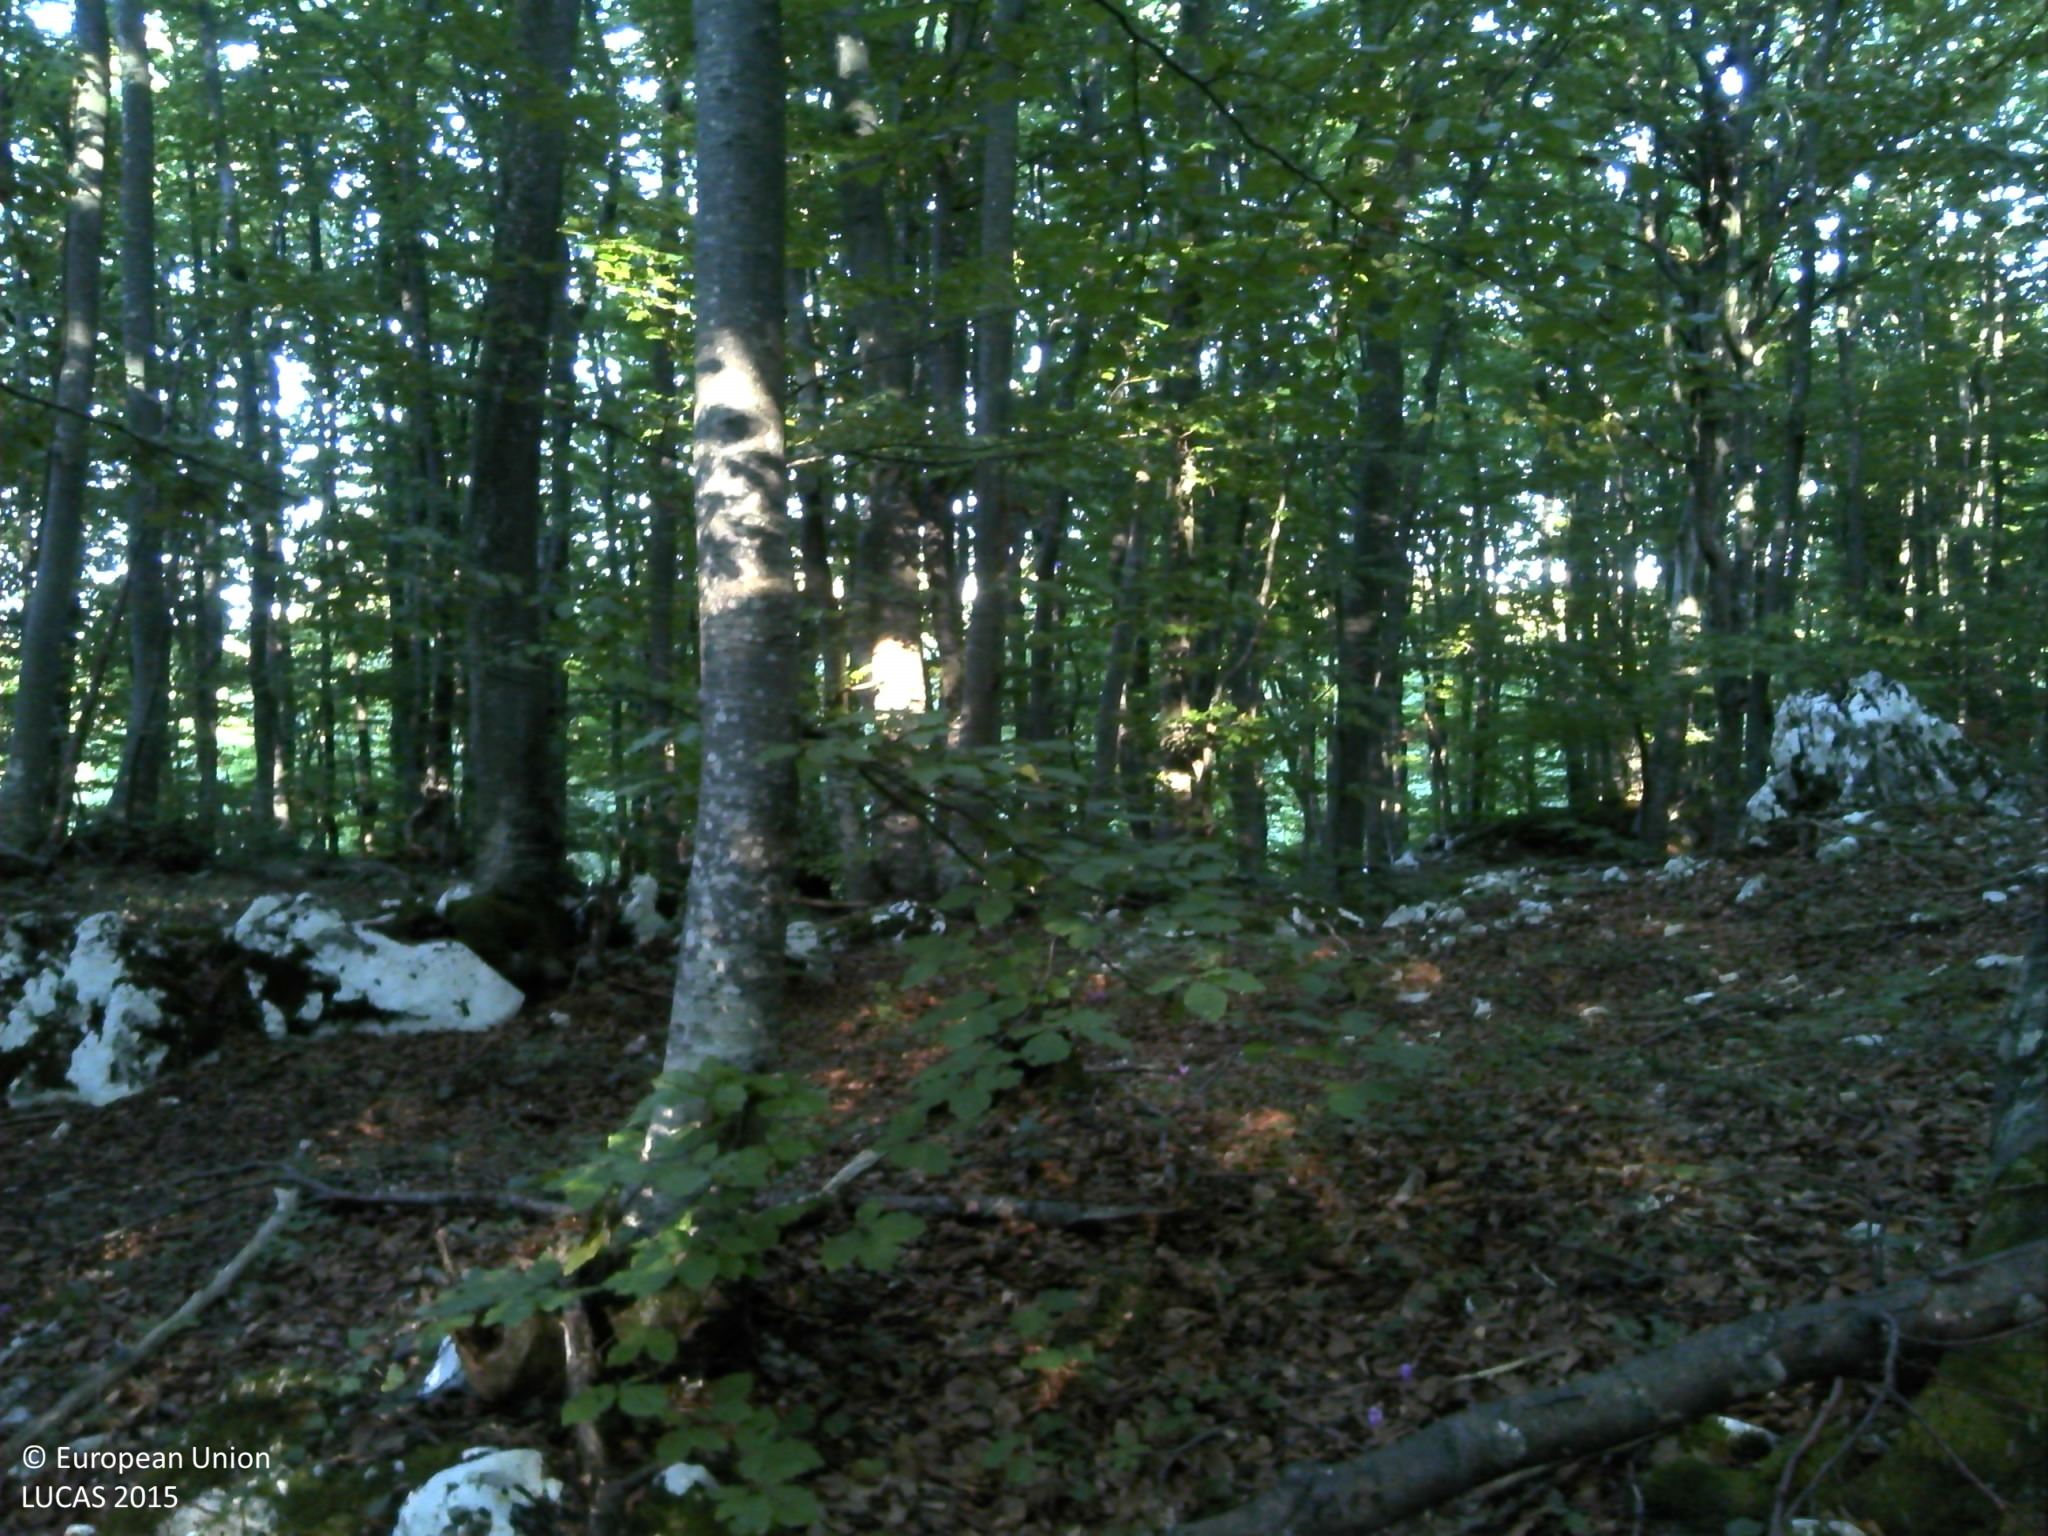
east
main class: Woodland
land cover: Broadleaved woodland
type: beech forest
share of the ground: > 75 %
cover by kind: broadleaved forest trees 90 %, lichens and mosses 5 %, consolidated bare surface 5 %
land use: Forestry
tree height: > 5 m
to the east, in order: Broadleaved woodland; Electric lines; Broadleaved woodland; Tracks; Broadleaved woodland
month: August
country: HR
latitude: 44.9012
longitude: 15.6556
